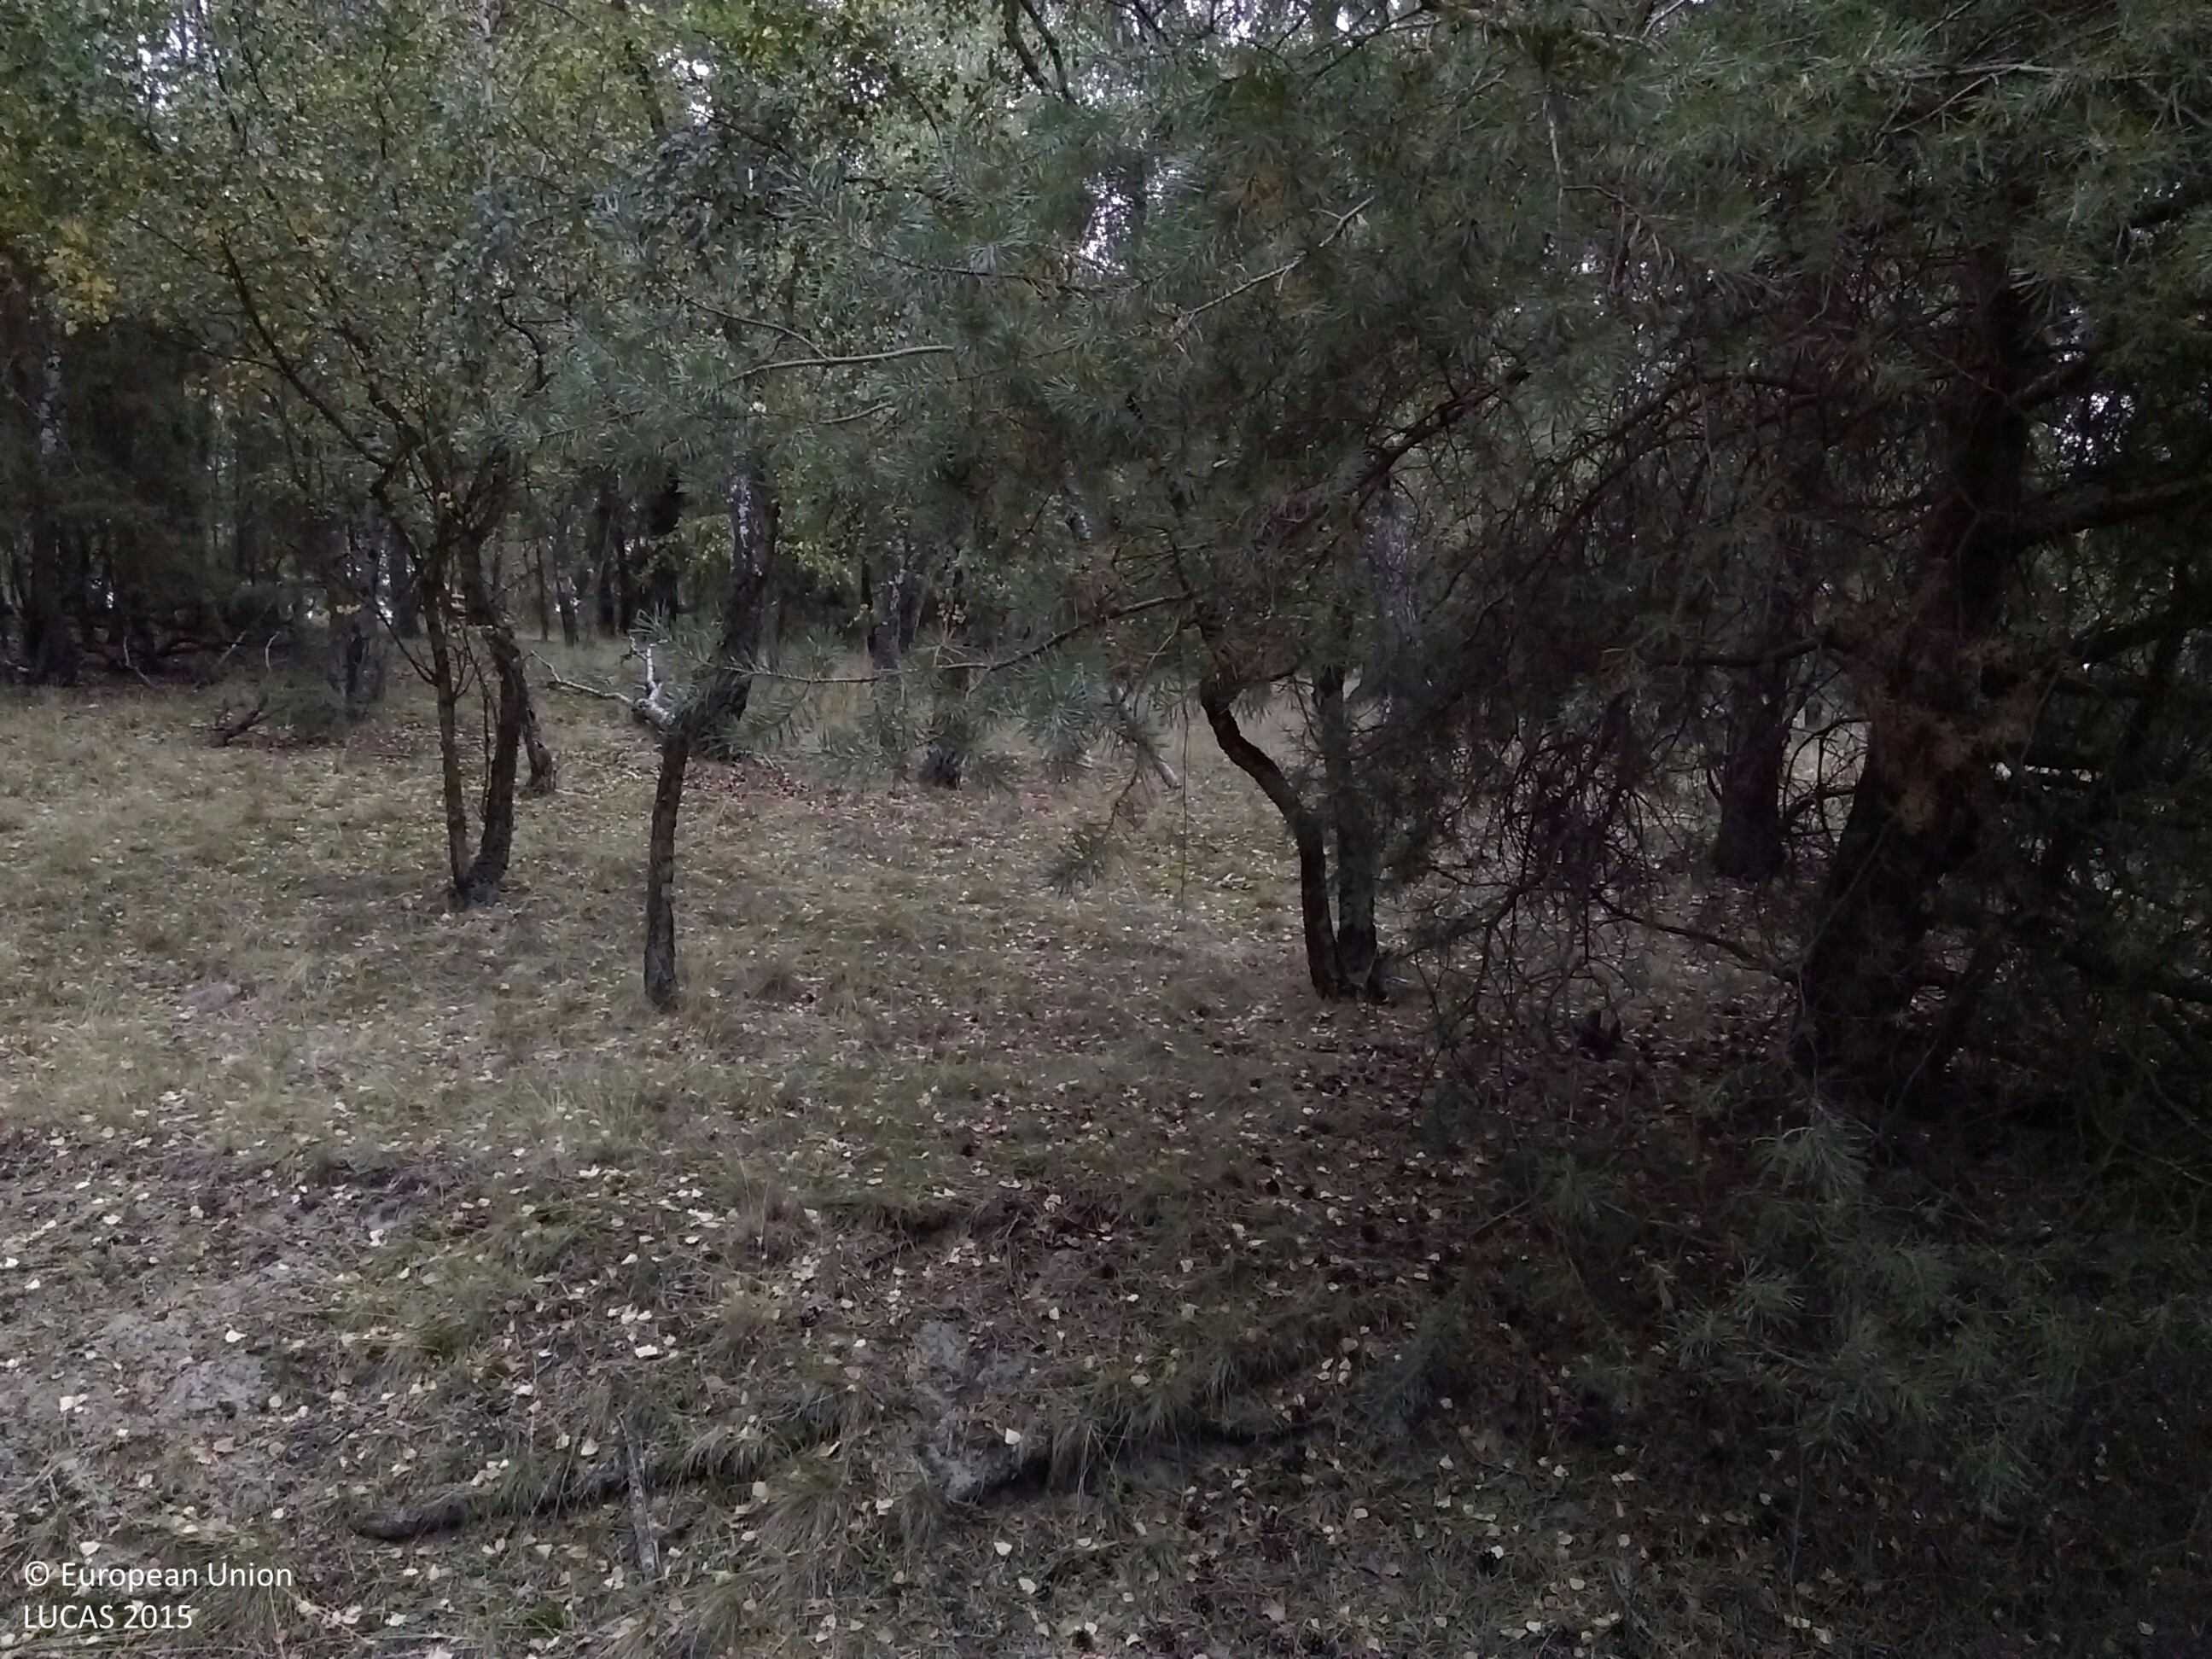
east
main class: Woodland
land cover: Pine dominated mixed woodland
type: hemiboreal forest and nemoral coniferous forest and mixed broadleaved-coniferous forest
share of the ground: 50 - 75 %
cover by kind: coniferous forest trees 40 %, broadleaved forest trees 30 %, herbaceous plants 15 %, unconsolidated bare surface 15 %
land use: Forestry
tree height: > 5 m
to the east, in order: Pine dominated mixed woodland; Rye
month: August
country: PL
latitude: 52.2805
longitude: 15.6183
